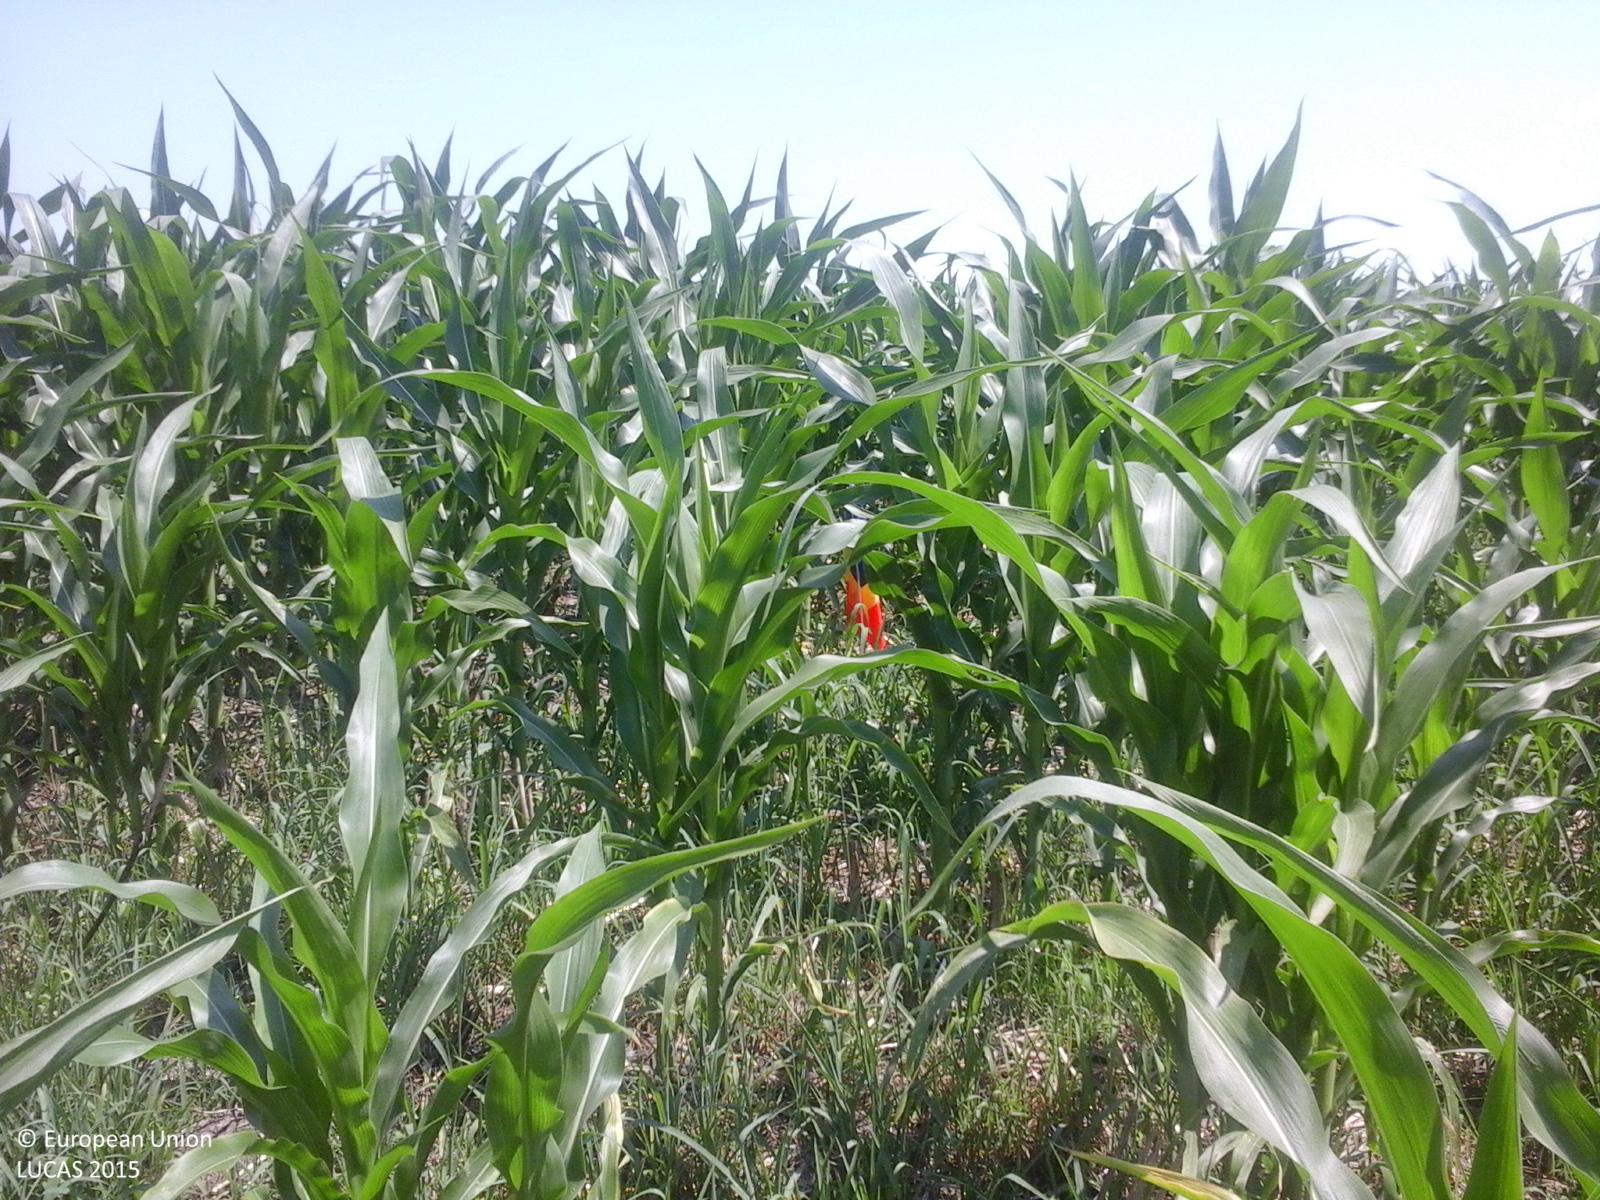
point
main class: Cropland
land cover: Maize
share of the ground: > 75 %
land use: Agriculture (excluding fallow land and kitchen gardens)
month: June
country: RO
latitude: 44.0951
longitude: 26.4352
